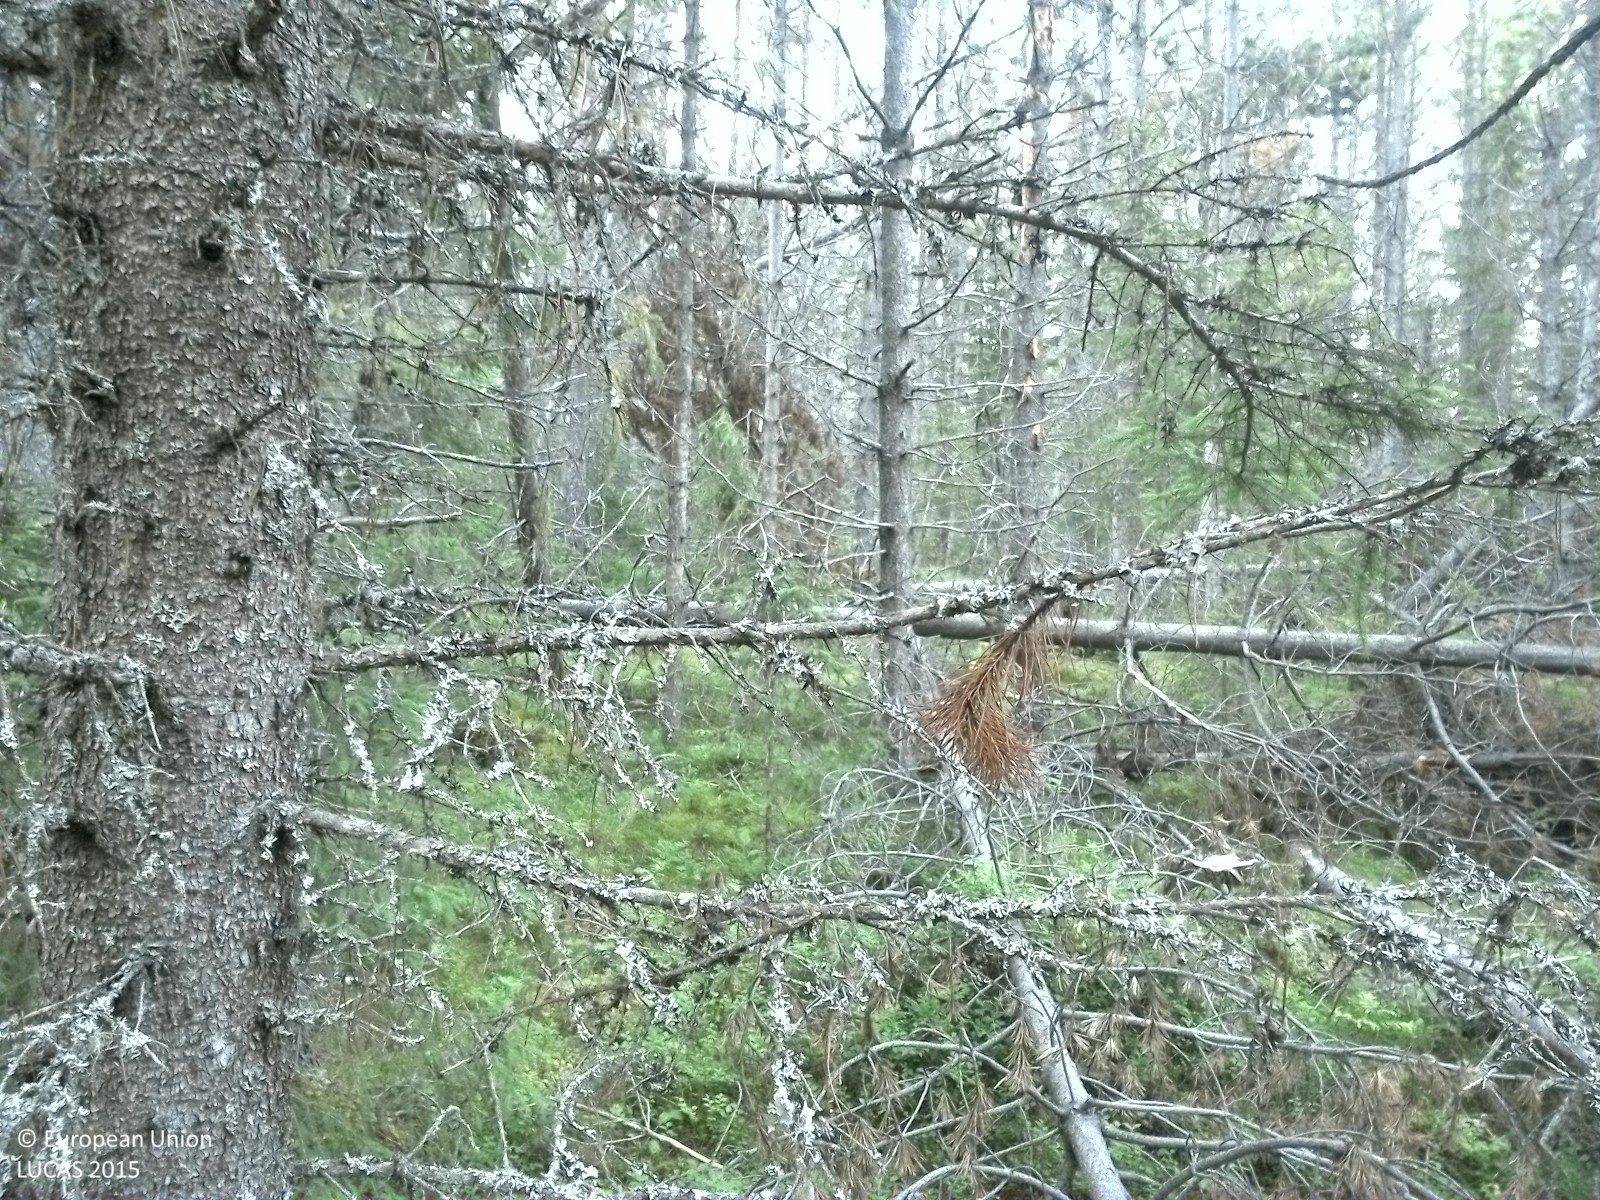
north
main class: Woodland
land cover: Pine dominated coniferous woodland
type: exotic forest
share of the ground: 50 - 75 %
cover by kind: coniferous forest trees 65 %, shrubs 25 %, lichens and mosses 10 %
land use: Forestry
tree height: > 5 m
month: August
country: SE
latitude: 62.7420
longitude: 16.5343
